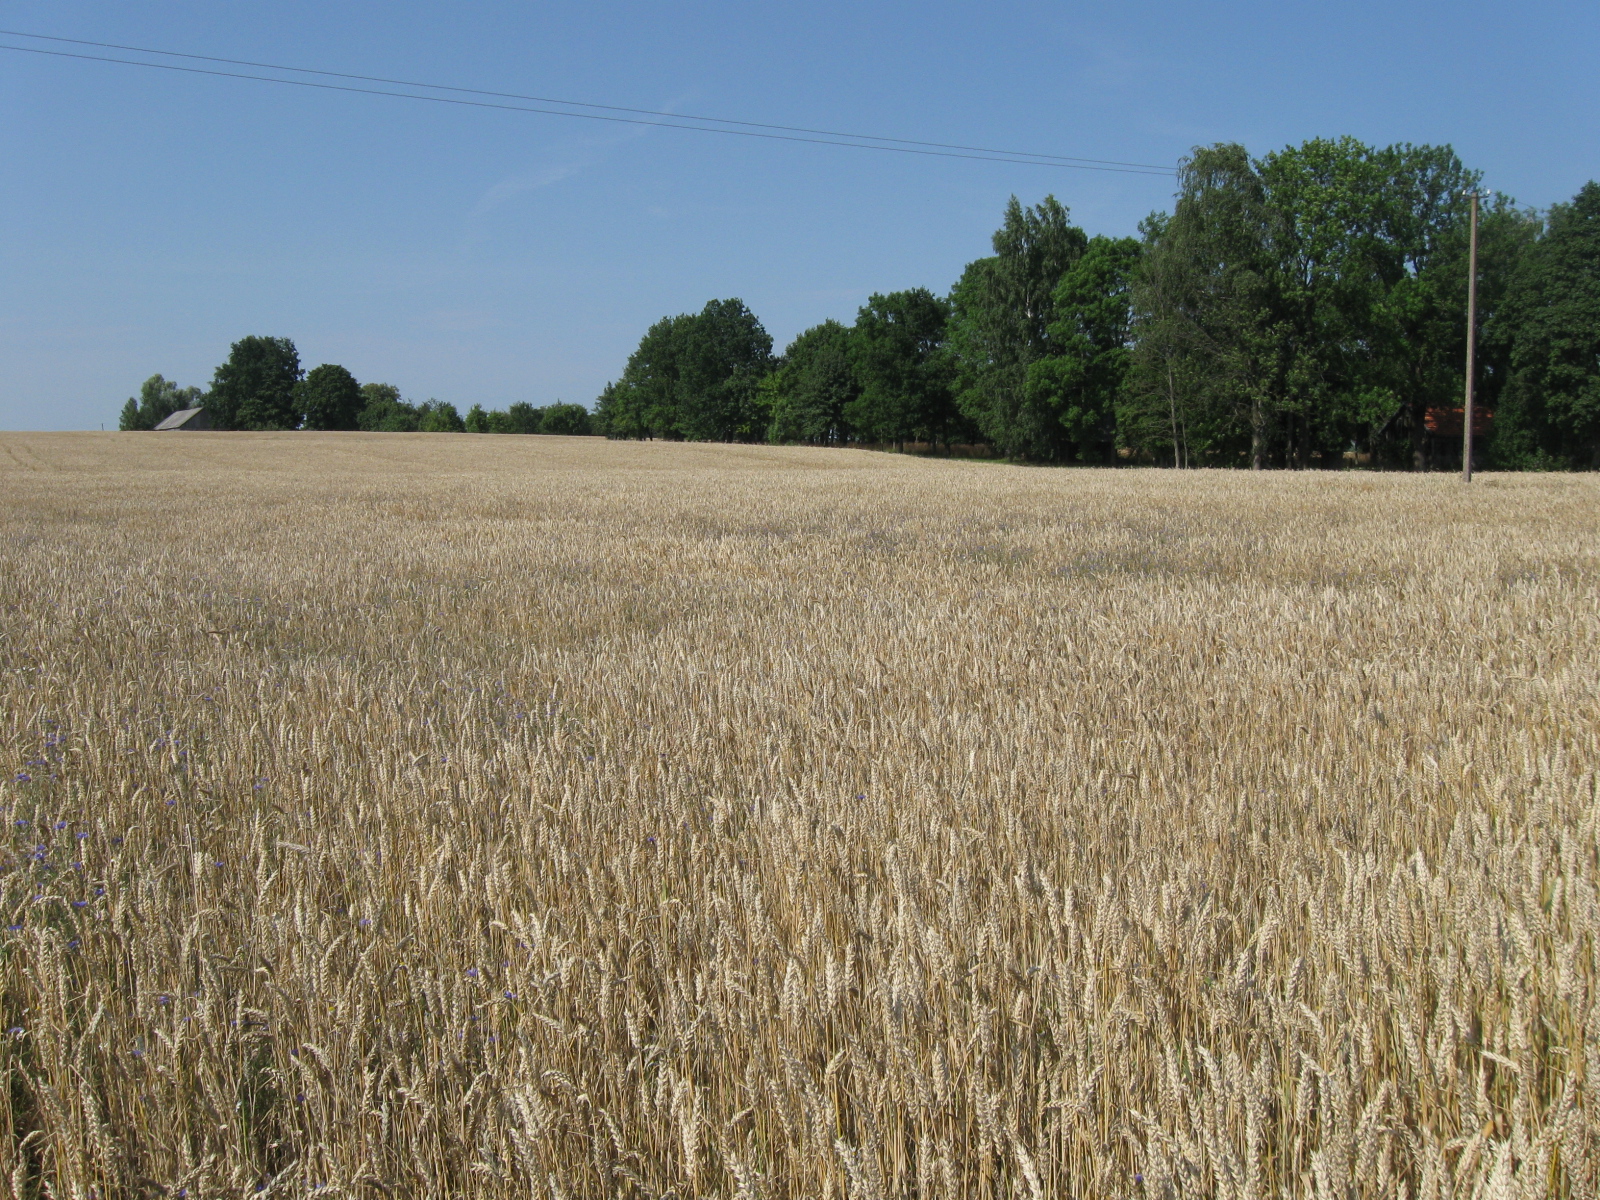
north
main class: Cropland
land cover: Common wheat
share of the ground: > 75 %
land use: Agriculture (excluding fallow land and kitchen gardens)
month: July
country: LT
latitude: 54.5802
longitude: 23.6219
